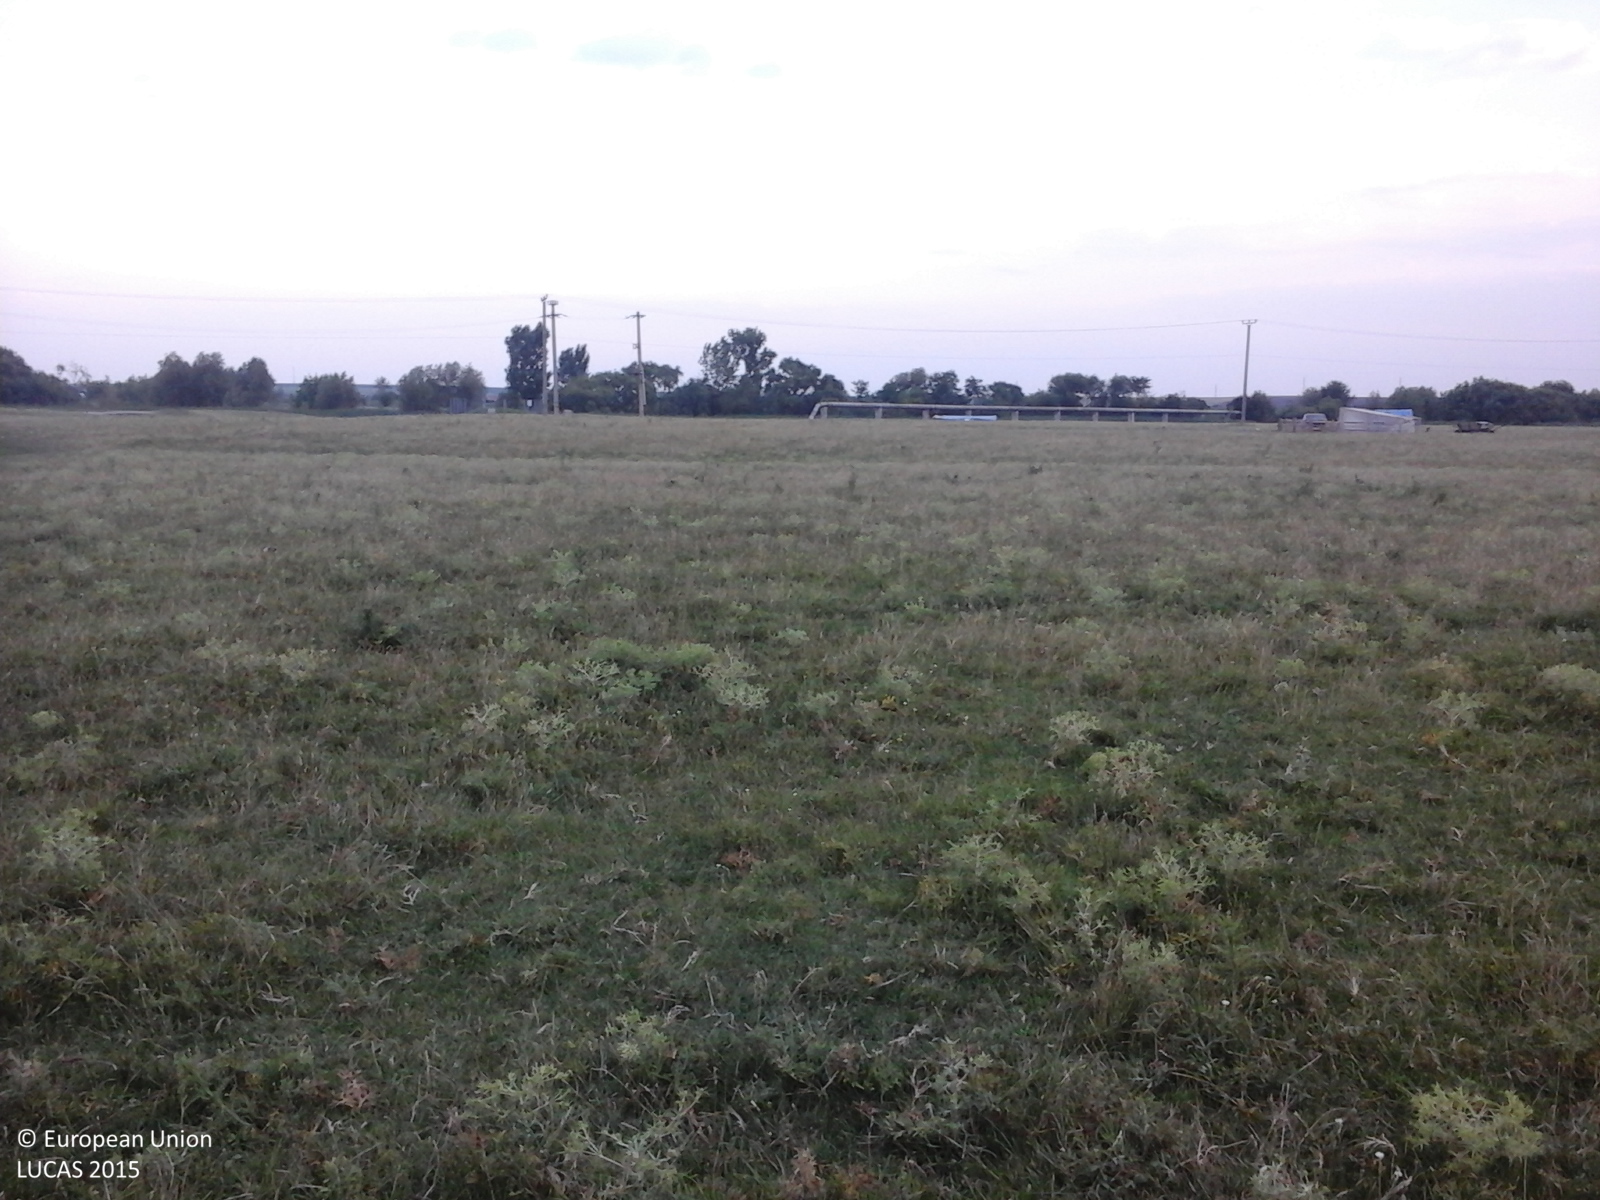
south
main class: Grassland
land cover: Grassland without tree/shrub cover
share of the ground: > 75 %
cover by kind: herbaceous plants 100 %
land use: Agriculture (excluding fallow land and kitchen gardens)
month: July
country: RO
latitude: 44.0666
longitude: 25.0727
